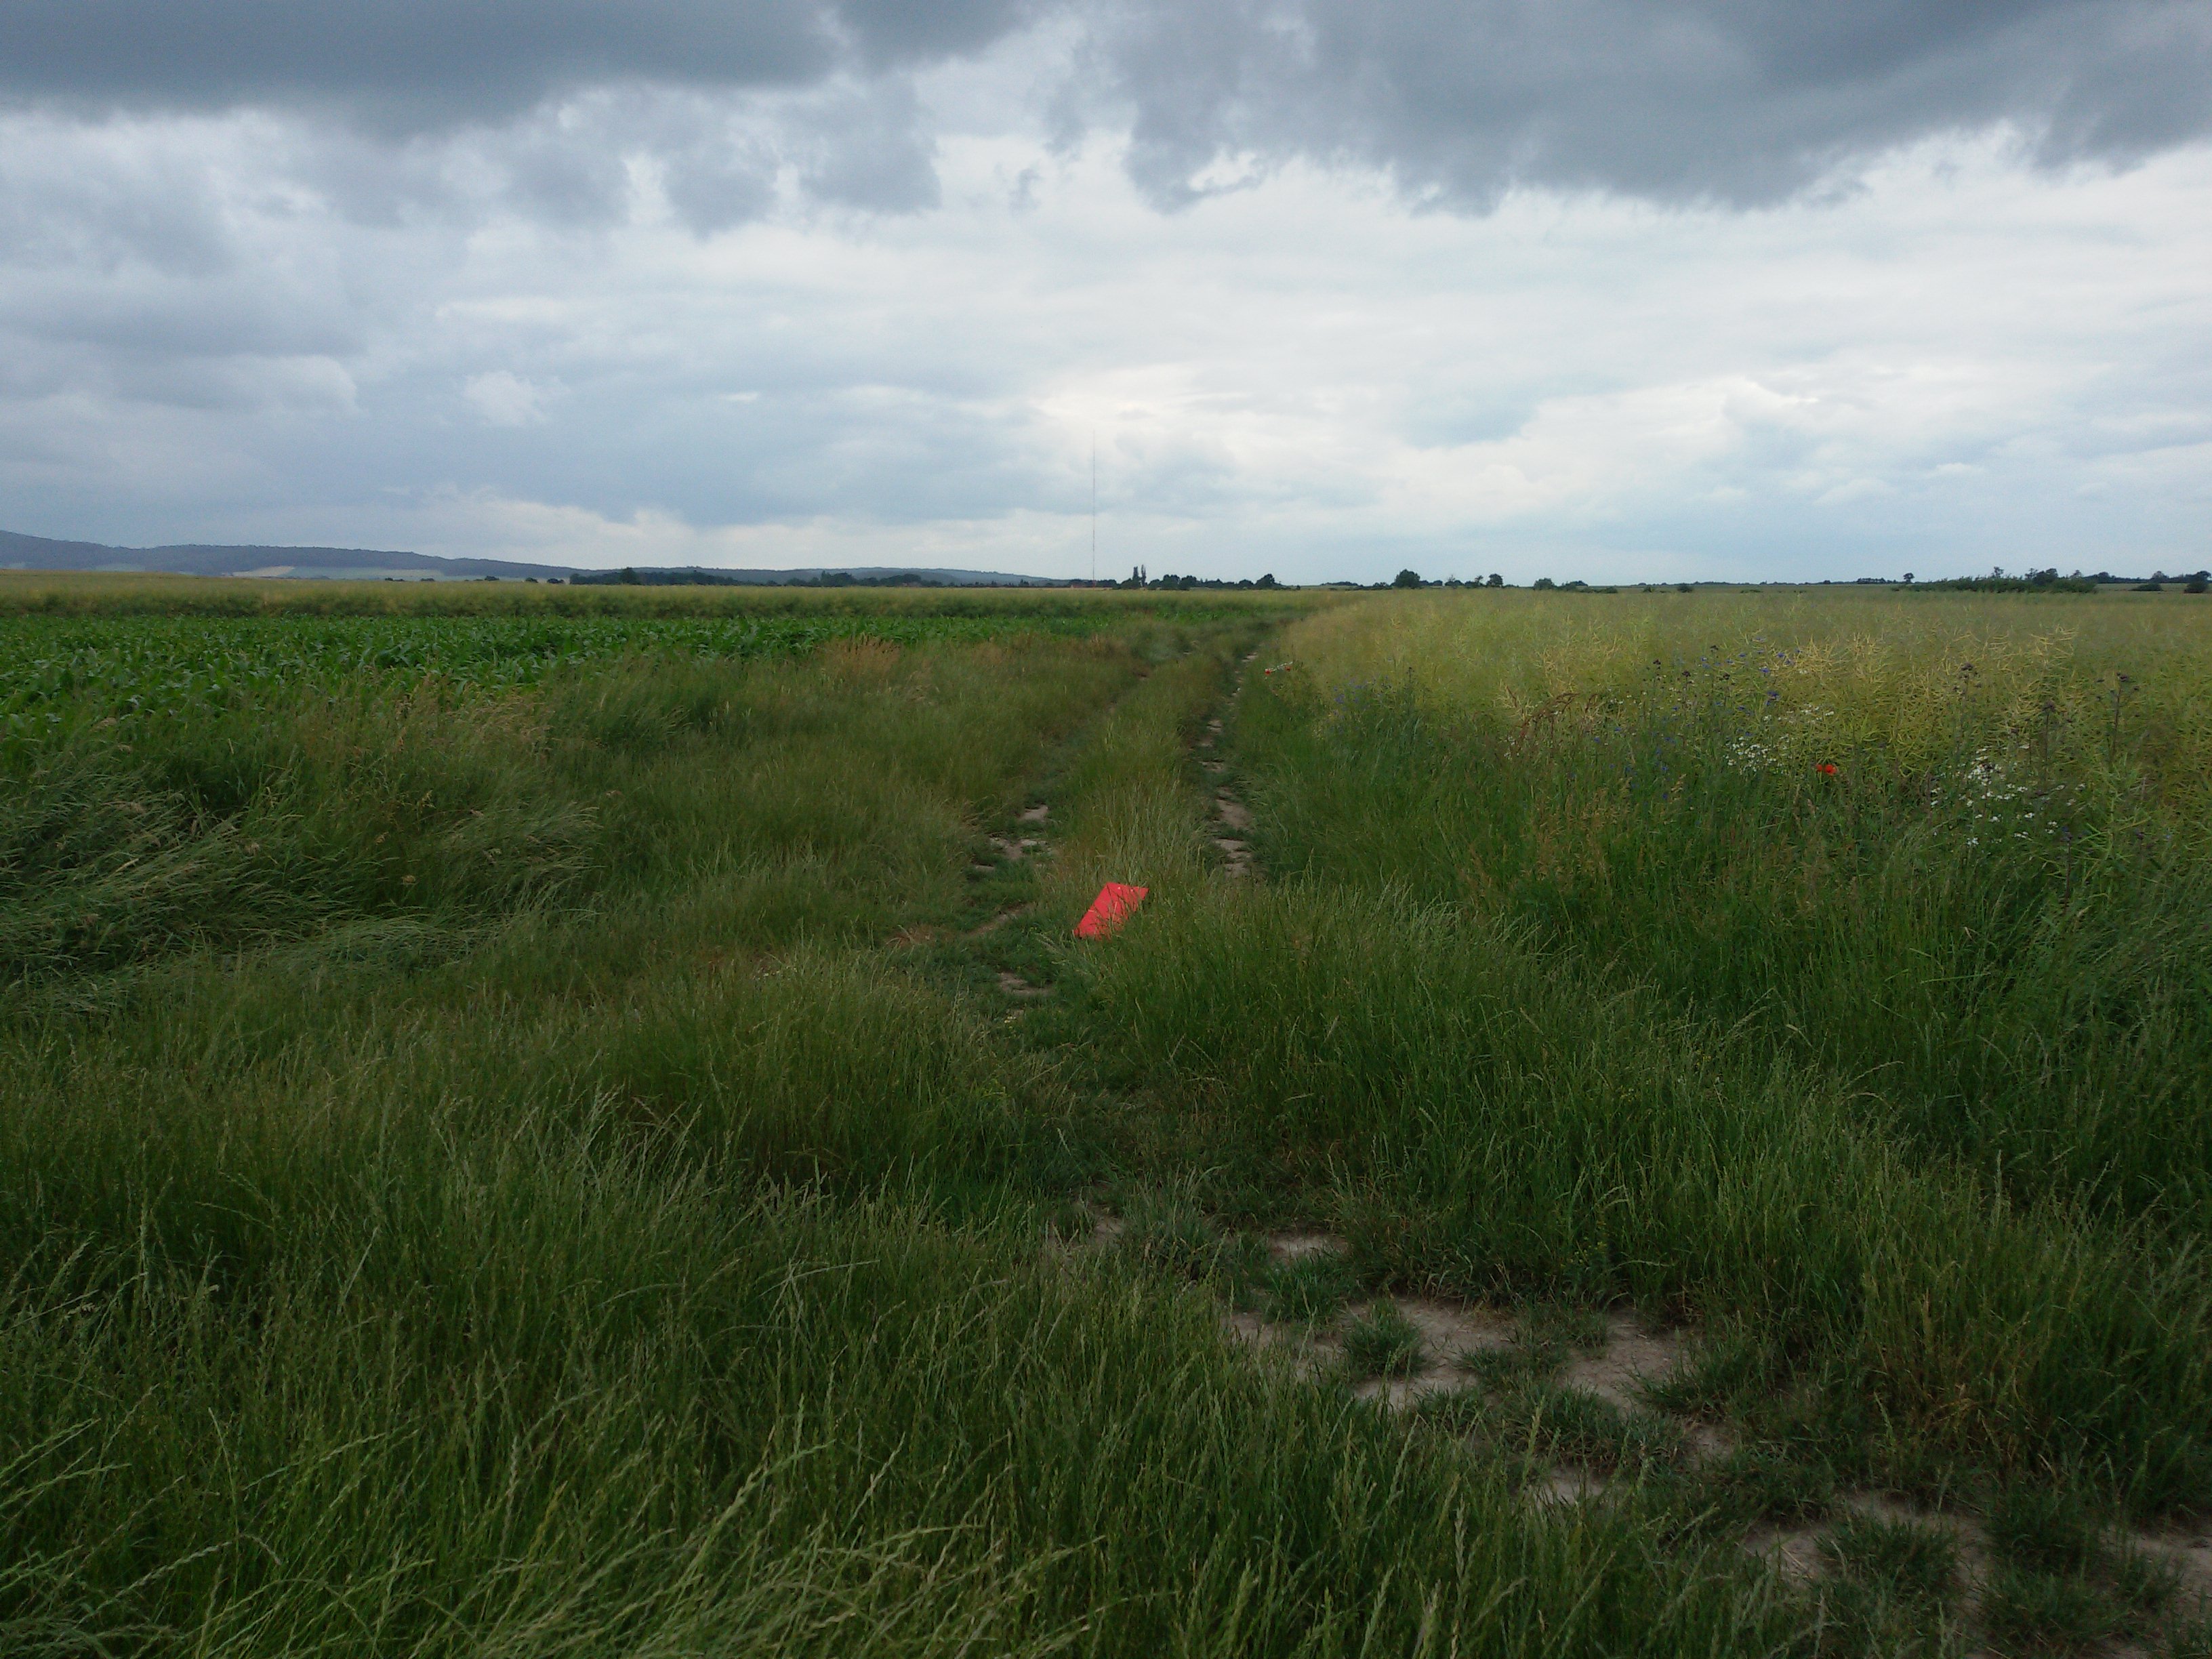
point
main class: Cropland
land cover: Rape and turnip rape
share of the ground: > 75 %
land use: Agriculture (excluding fallow land and kitchen gardens)
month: June
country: PL
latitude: 50.6956
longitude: 17.2171
